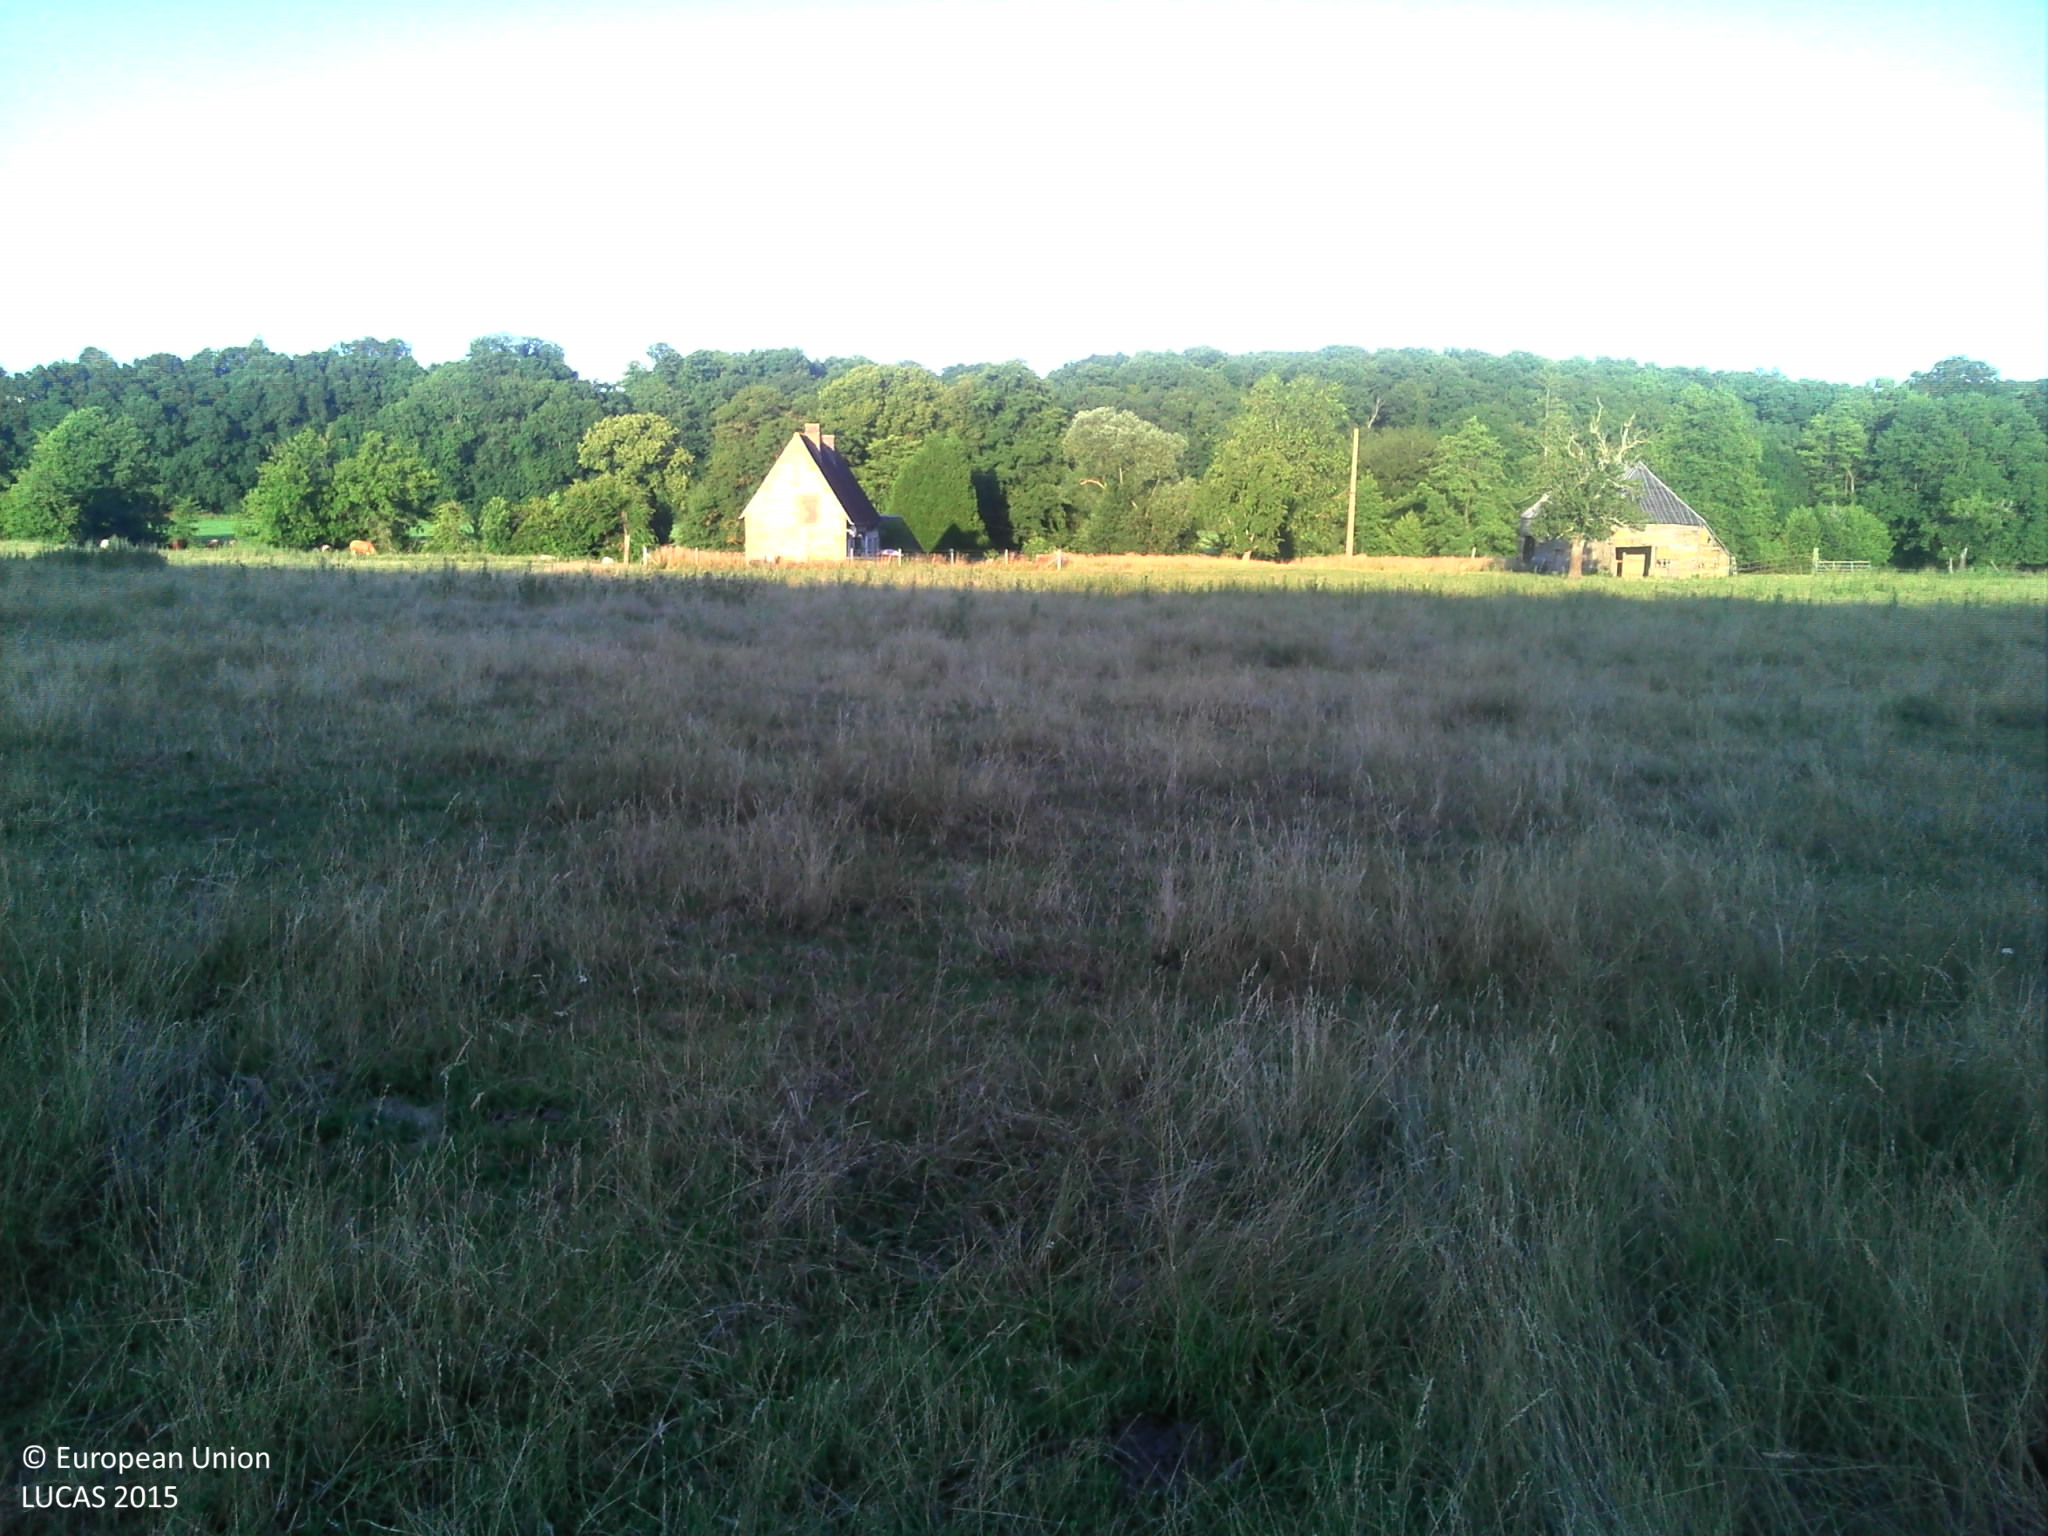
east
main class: Grassland
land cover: Grassland without tree/shrub cover
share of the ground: > 75 %
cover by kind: herbaceous plants 100 %
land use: Agriculture (excluding fallow land and kitchen gardens)
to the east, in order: Grassland without tree/shrub cover; Fences; Grassland without tree/shrub cover; Abandoned hedges; Inland fresh running water; Abandoned hedges; Grassland without tree/shrub cover
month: July
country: FR
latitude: 48.9016
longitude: 0.7408
